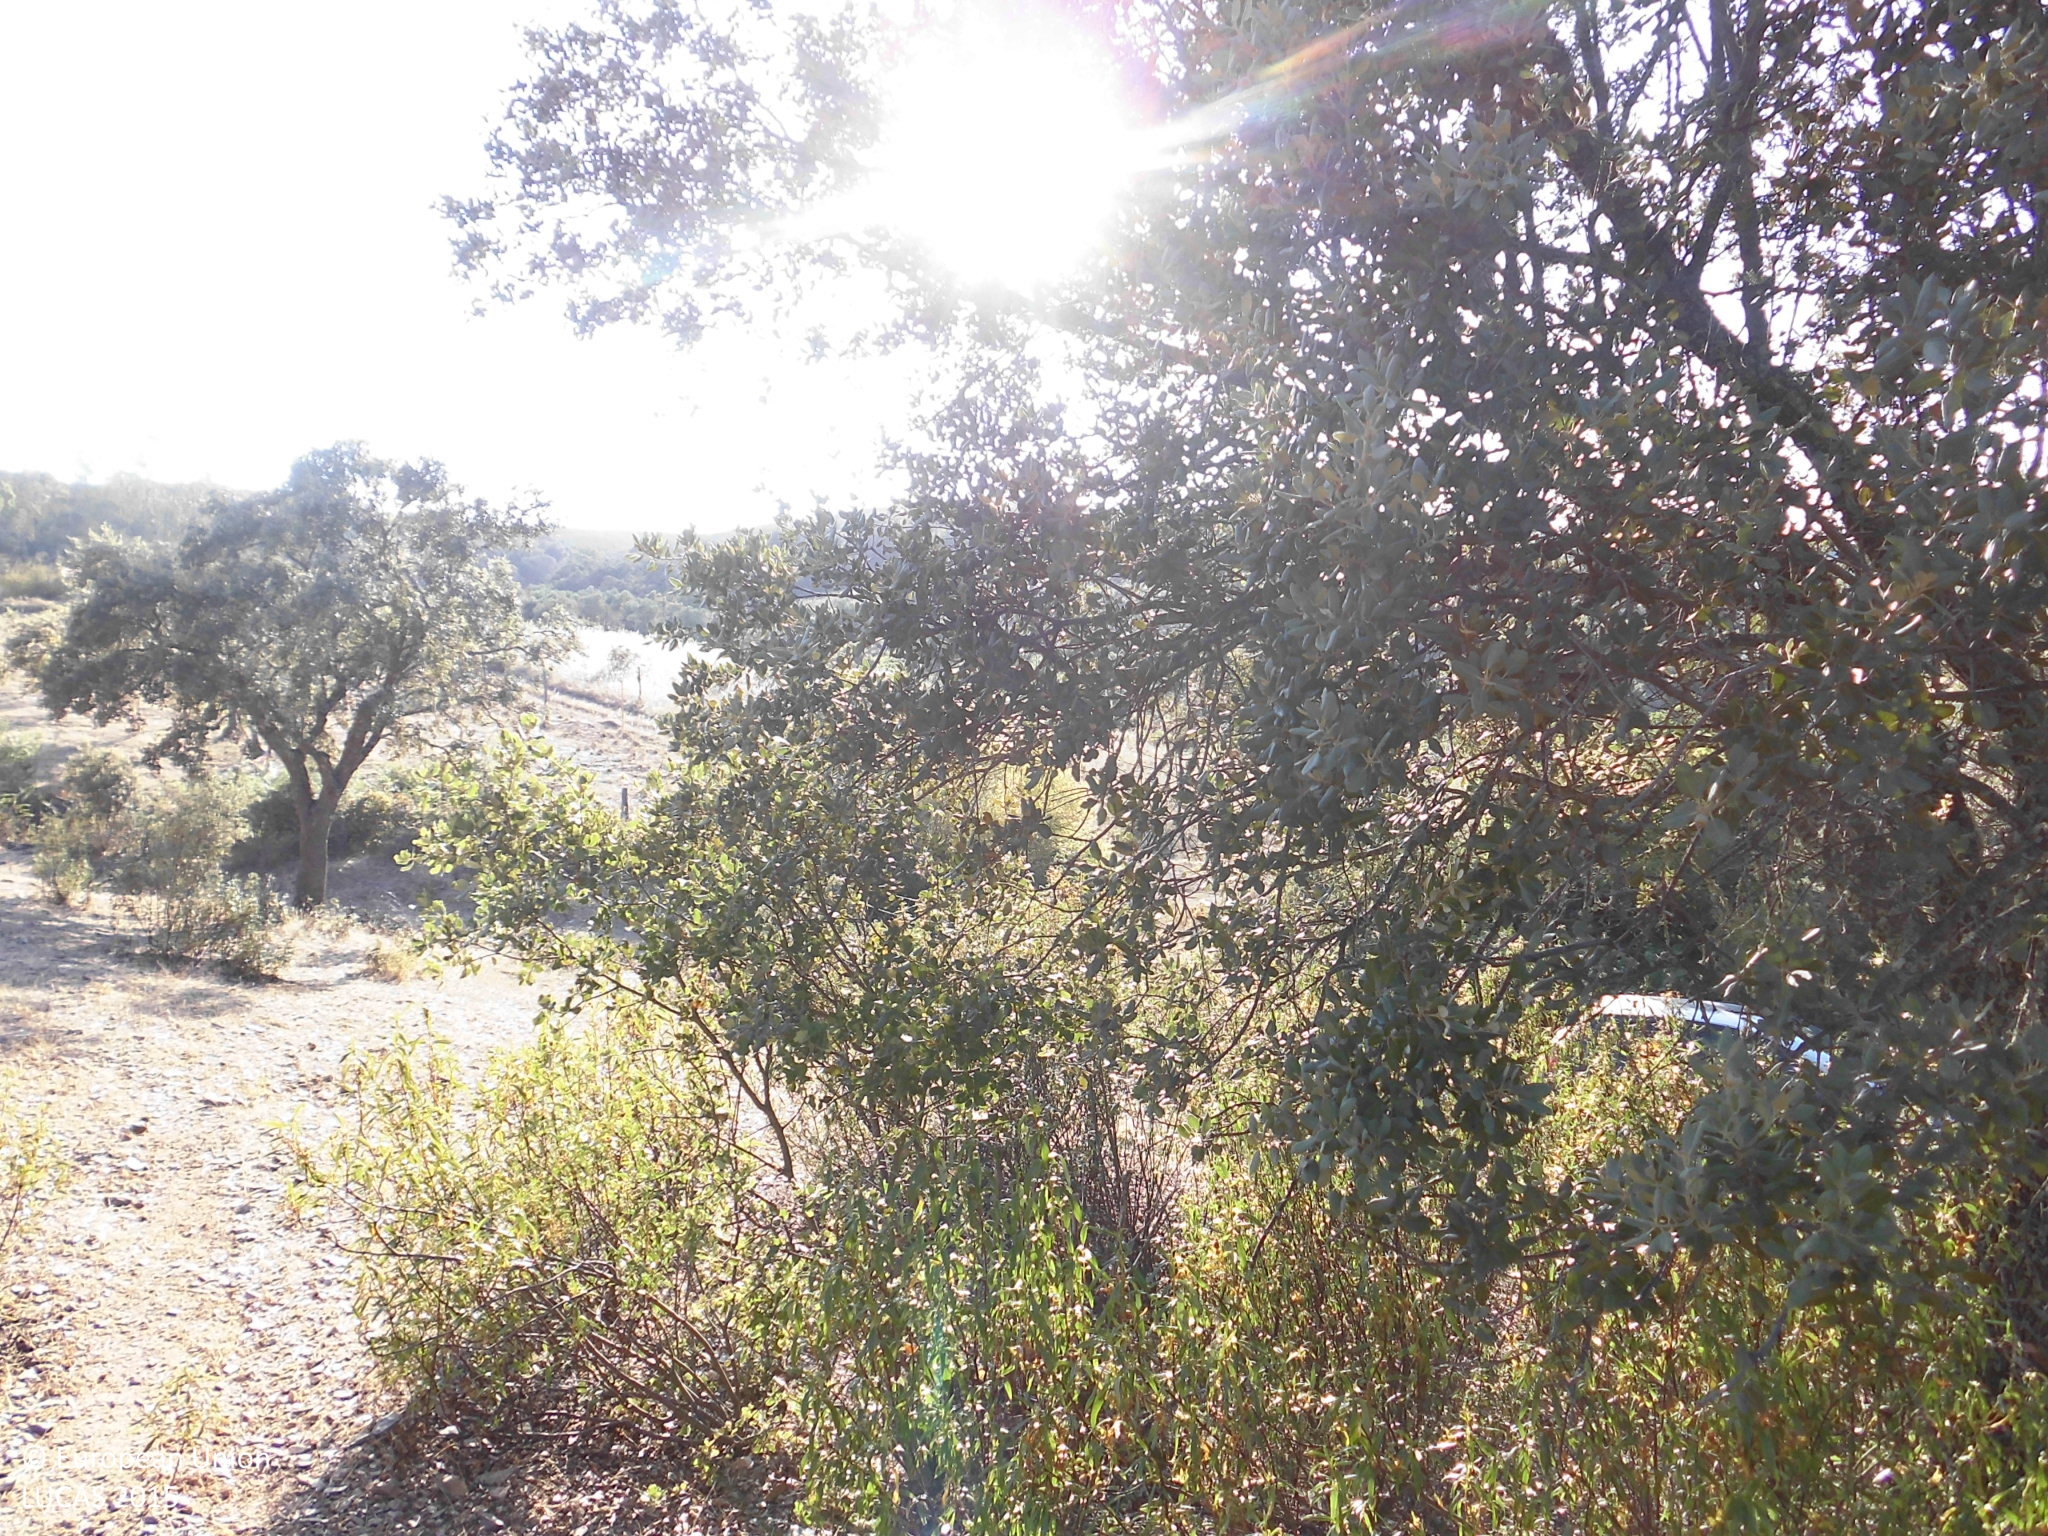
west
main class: Woodland
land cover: Broadleaved woodland
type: broadleaved evergreen forest
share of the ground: 25 - 50 %
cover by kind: broadleaved forest trees 35 %, shrubs 30 %, consolidated bare surface 25 %, herbaceous plants 10 %
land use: Semi-natural and natural areas not in use
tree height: > 5 m
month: July
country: ES
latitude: 39.6417
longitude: -5.5650
